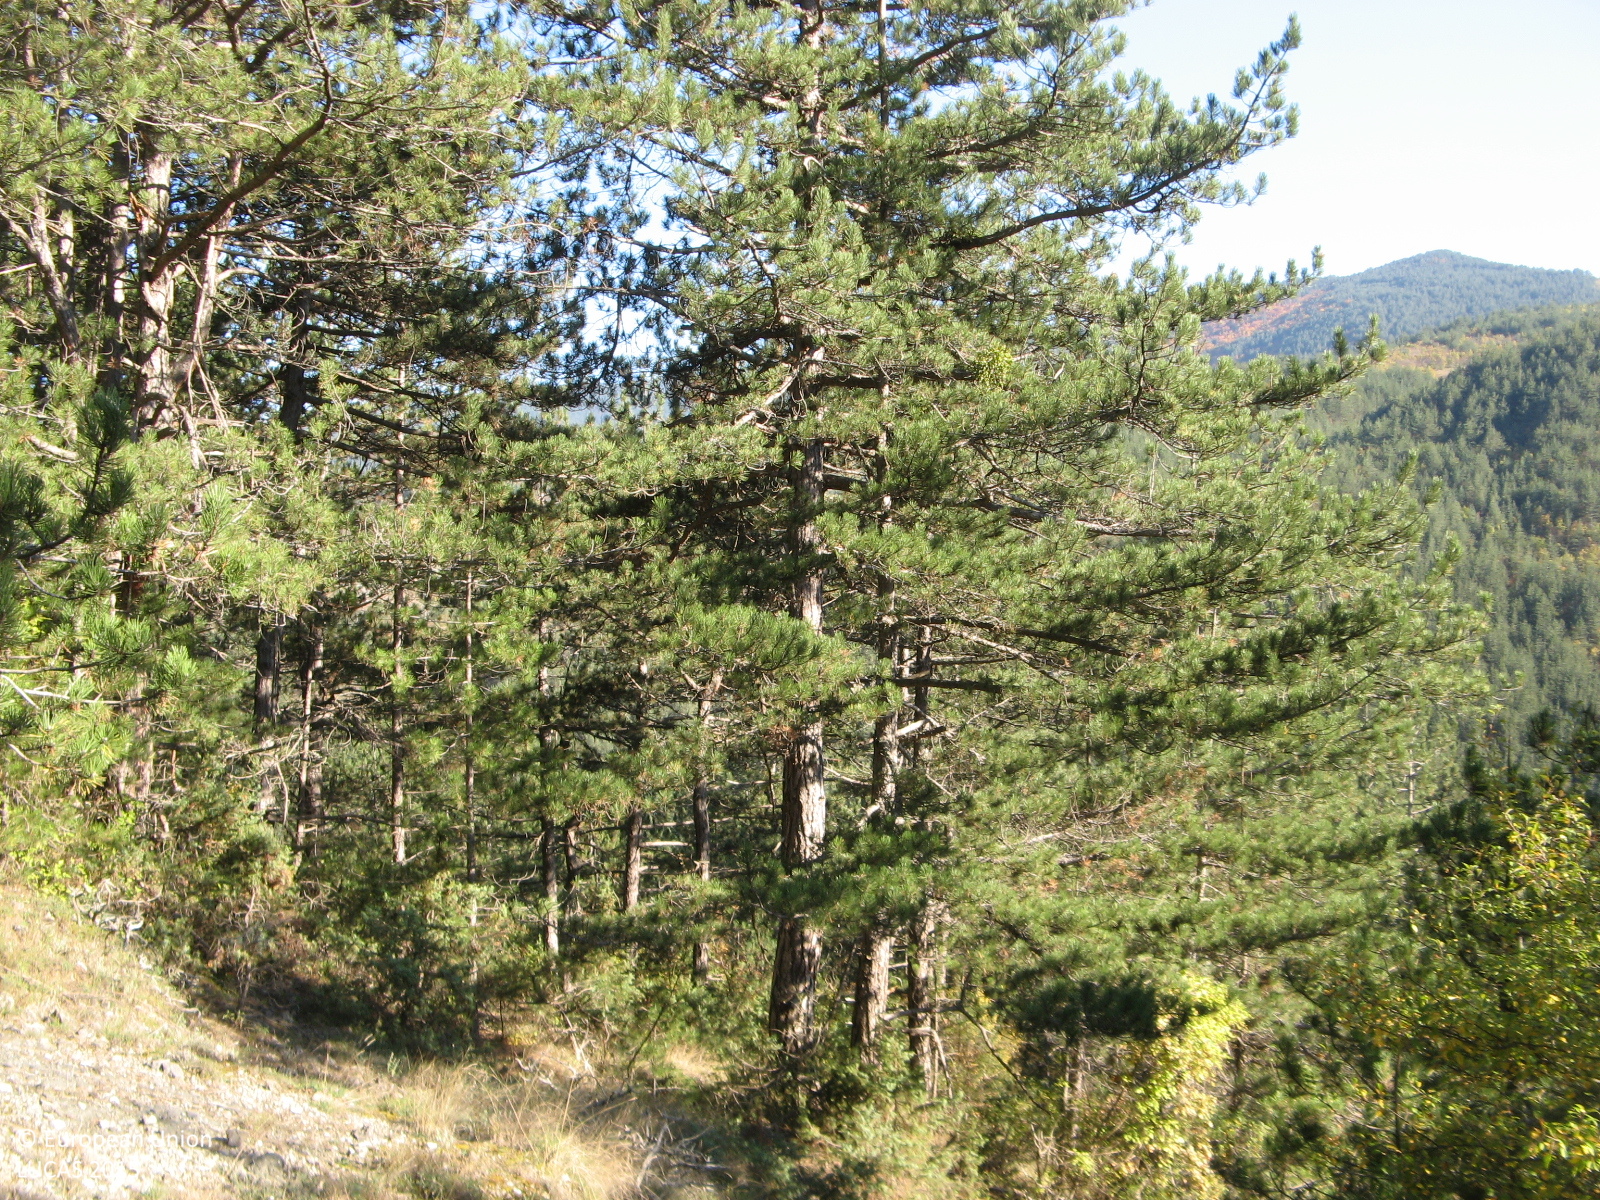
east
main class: Woodland
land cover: Pine dominated coniferous woodland
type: hemiboreal forest and nemoral coniferous forest and mixed broadleaved-coniferous forest
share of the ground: 50 - 75 %
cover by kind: coniferous forest trees 70 %, unconsolidated bare surface 15 %, herbaceous plants 10 %, shrubs 5 %
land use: Forestry
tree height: > 5 m
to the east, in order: Pine dominated coniferous woodland; Shrubland with sparse tree cover; Pine dominated coniferous woodland; Grassland with sparse tree/shrub cover; Artificial constructions; Paved roads, cycling and walking lanes; Shruby margins; Tracks; Grass margins
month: October
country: BG
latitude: 41.8524
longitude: 24.6815
